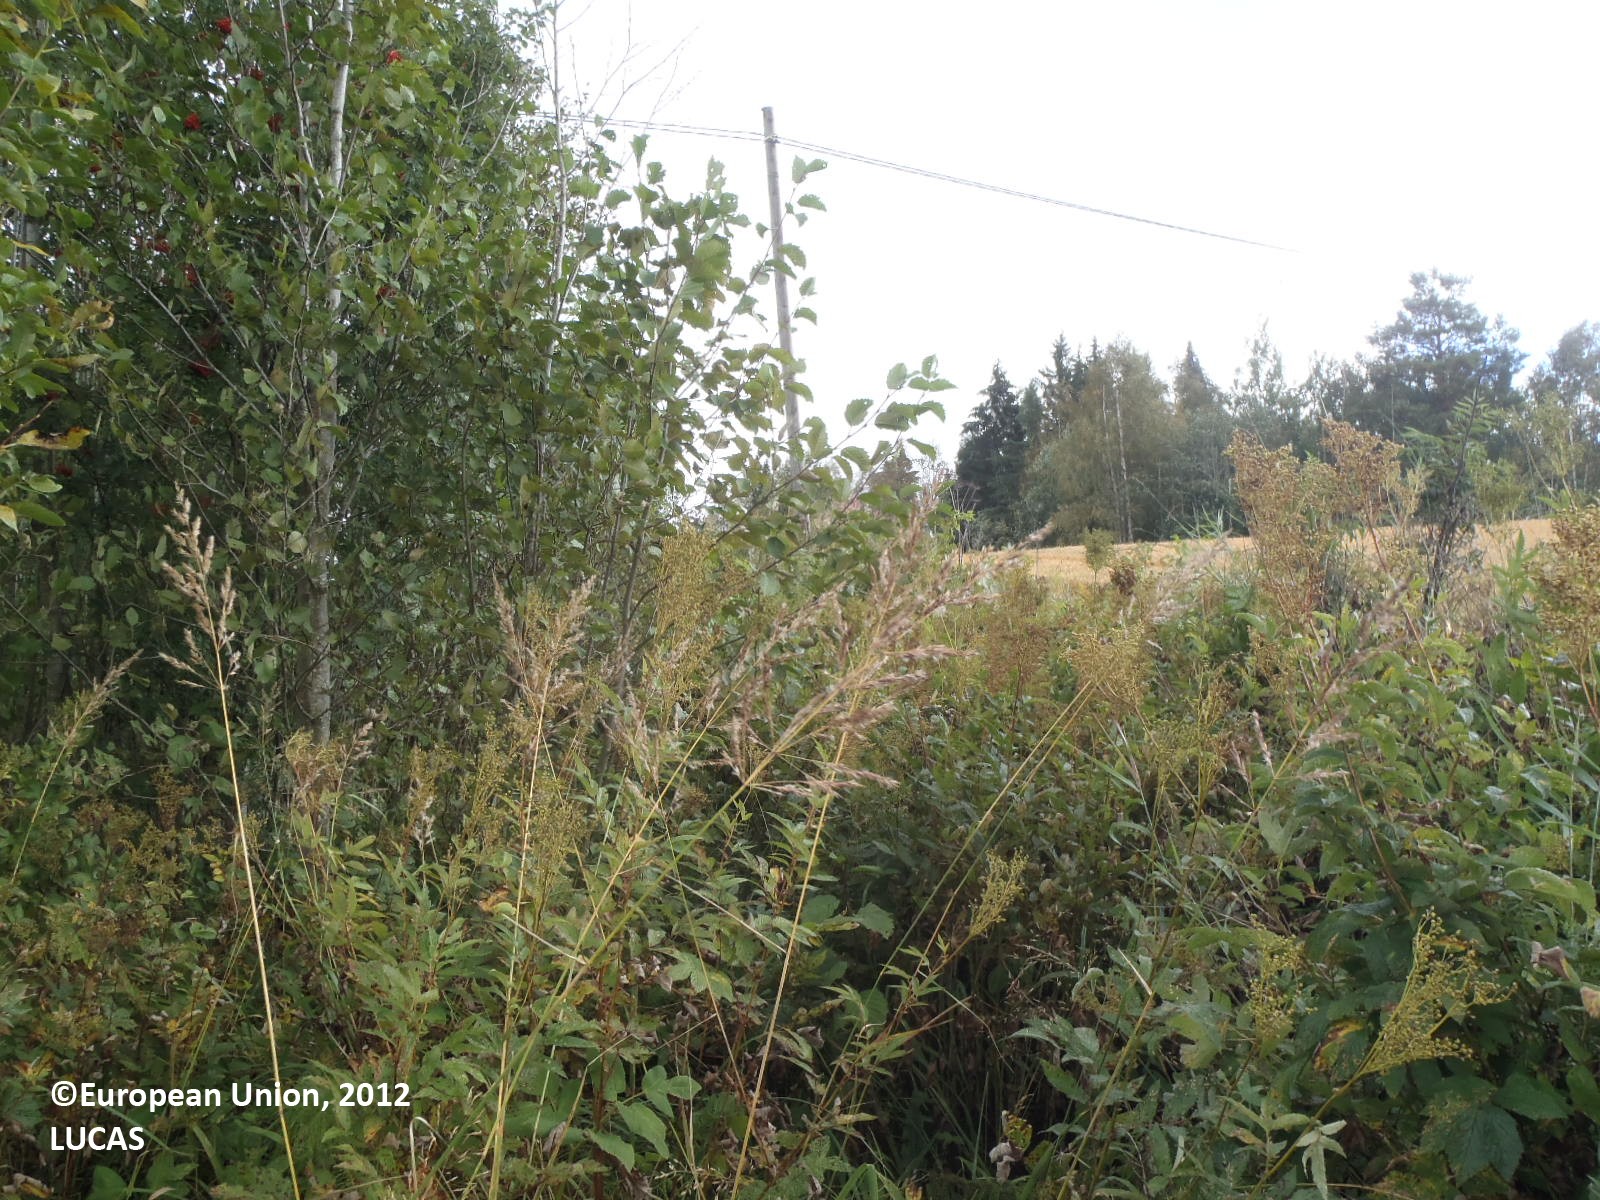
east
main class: Woodland
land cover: Broadleaved woodland
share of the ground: 50 - 75 %
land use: Forestry
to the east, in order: Broadleaved woodland; Other bare soil; Grass margins; Paved roads, cycling and walking lanes; Grass margins; Managed hedges; Grassland without tree/shrub cover; Sand; Grassland without tree/shrub cover; Other bare soil
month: September
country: FI
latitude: 61.6450
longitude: 22.7690
